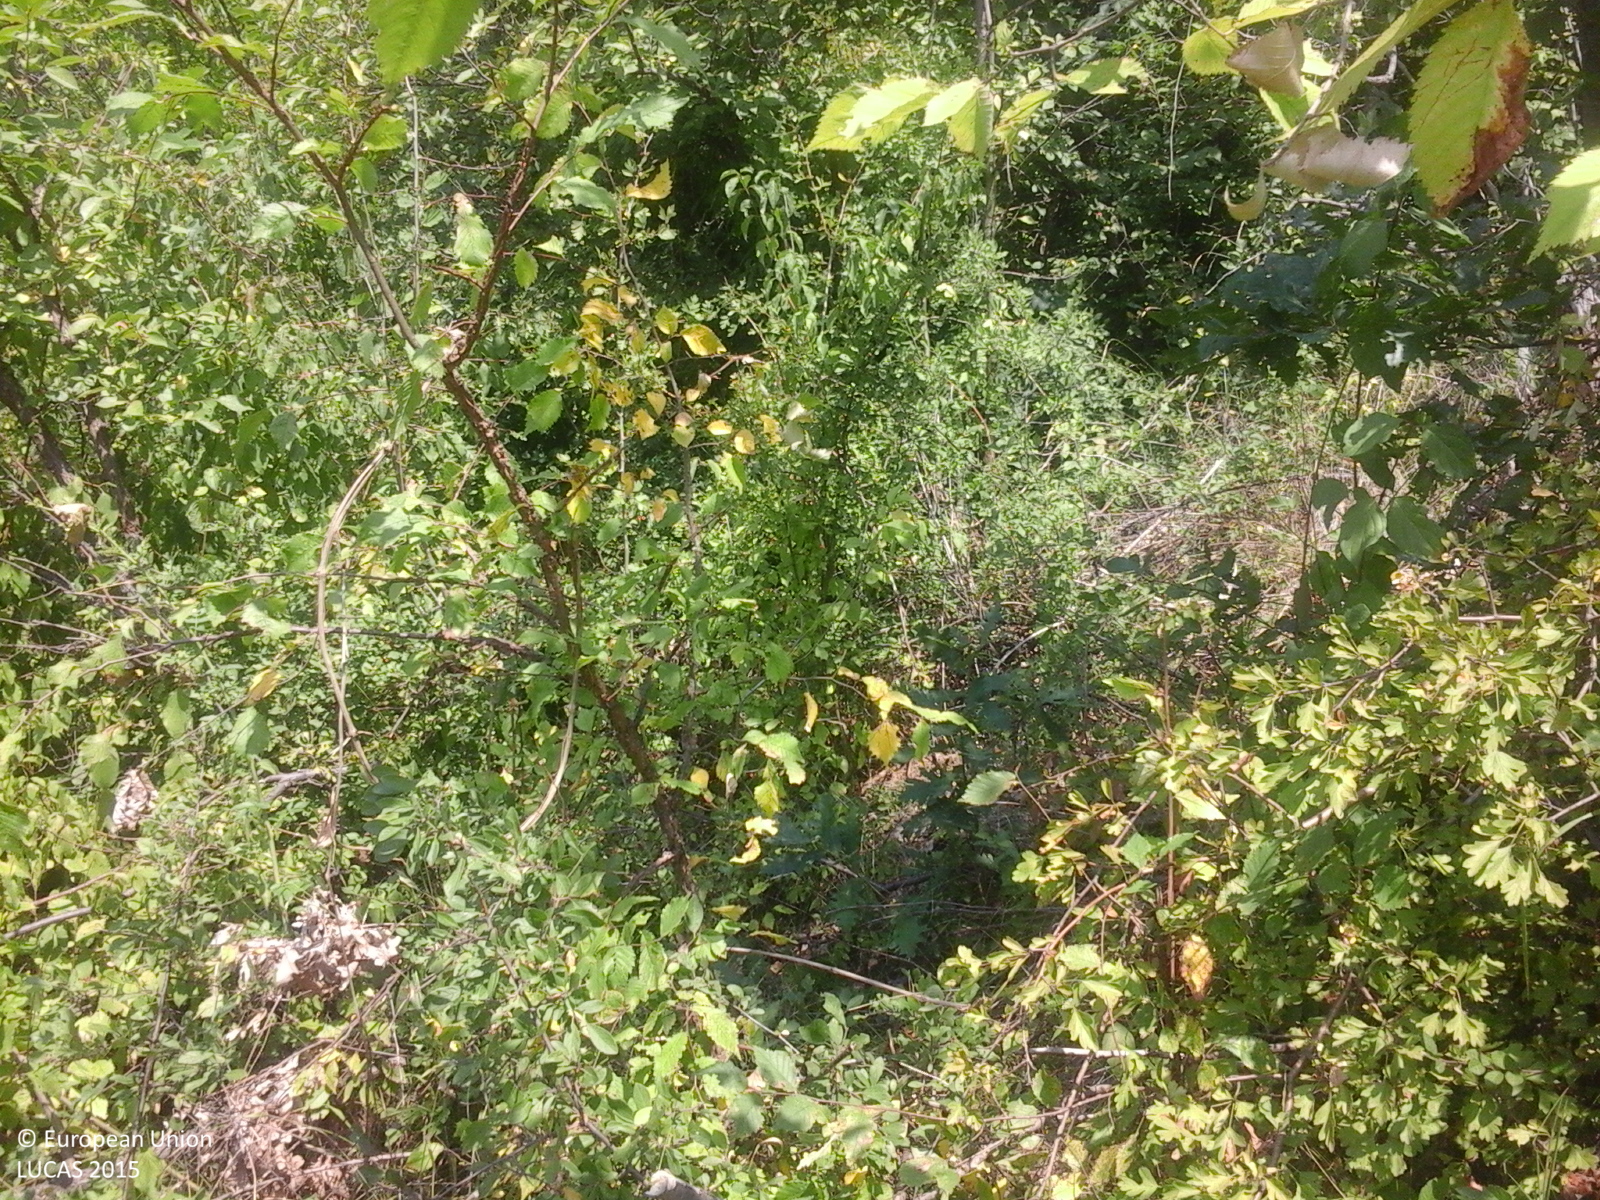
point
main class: Woodland
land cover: Broadleaved woodland
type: acidophilous oak and oak-birch forest
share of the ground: > 75 %
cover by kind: broadleaved forest trees 100 %
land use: Forestry
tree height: > 5 m
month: August
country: RO
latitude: 44.5801
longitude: 23.0568
